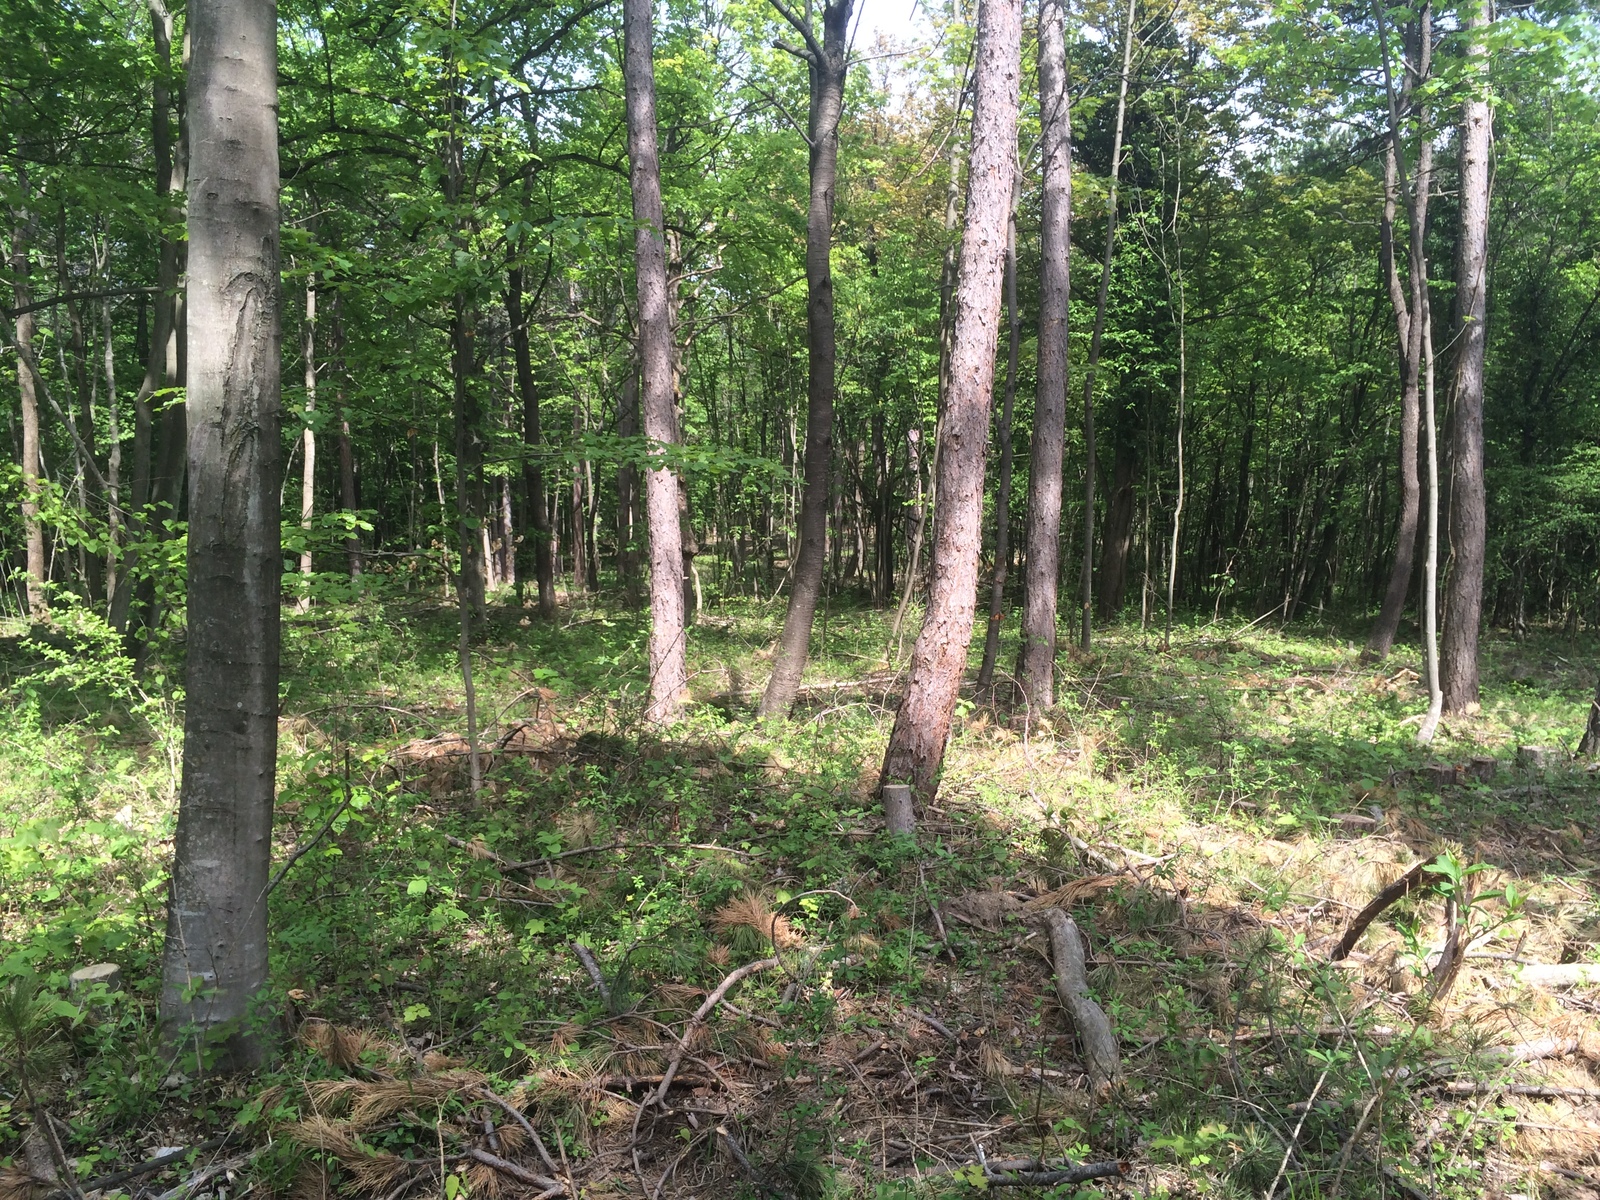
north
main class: Woodland
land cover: Pine dominated mixed woodland
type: alpine coniferous forest
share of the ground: > 75 %
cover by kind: coniferous forest trees 40 %, broadleaved forest trees 40 %, shrubs 10 %, herbaceous plants 10 %
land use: Forestry
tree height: > 5 m
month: May
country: AT
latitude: 47.9242
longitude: 16.1733
